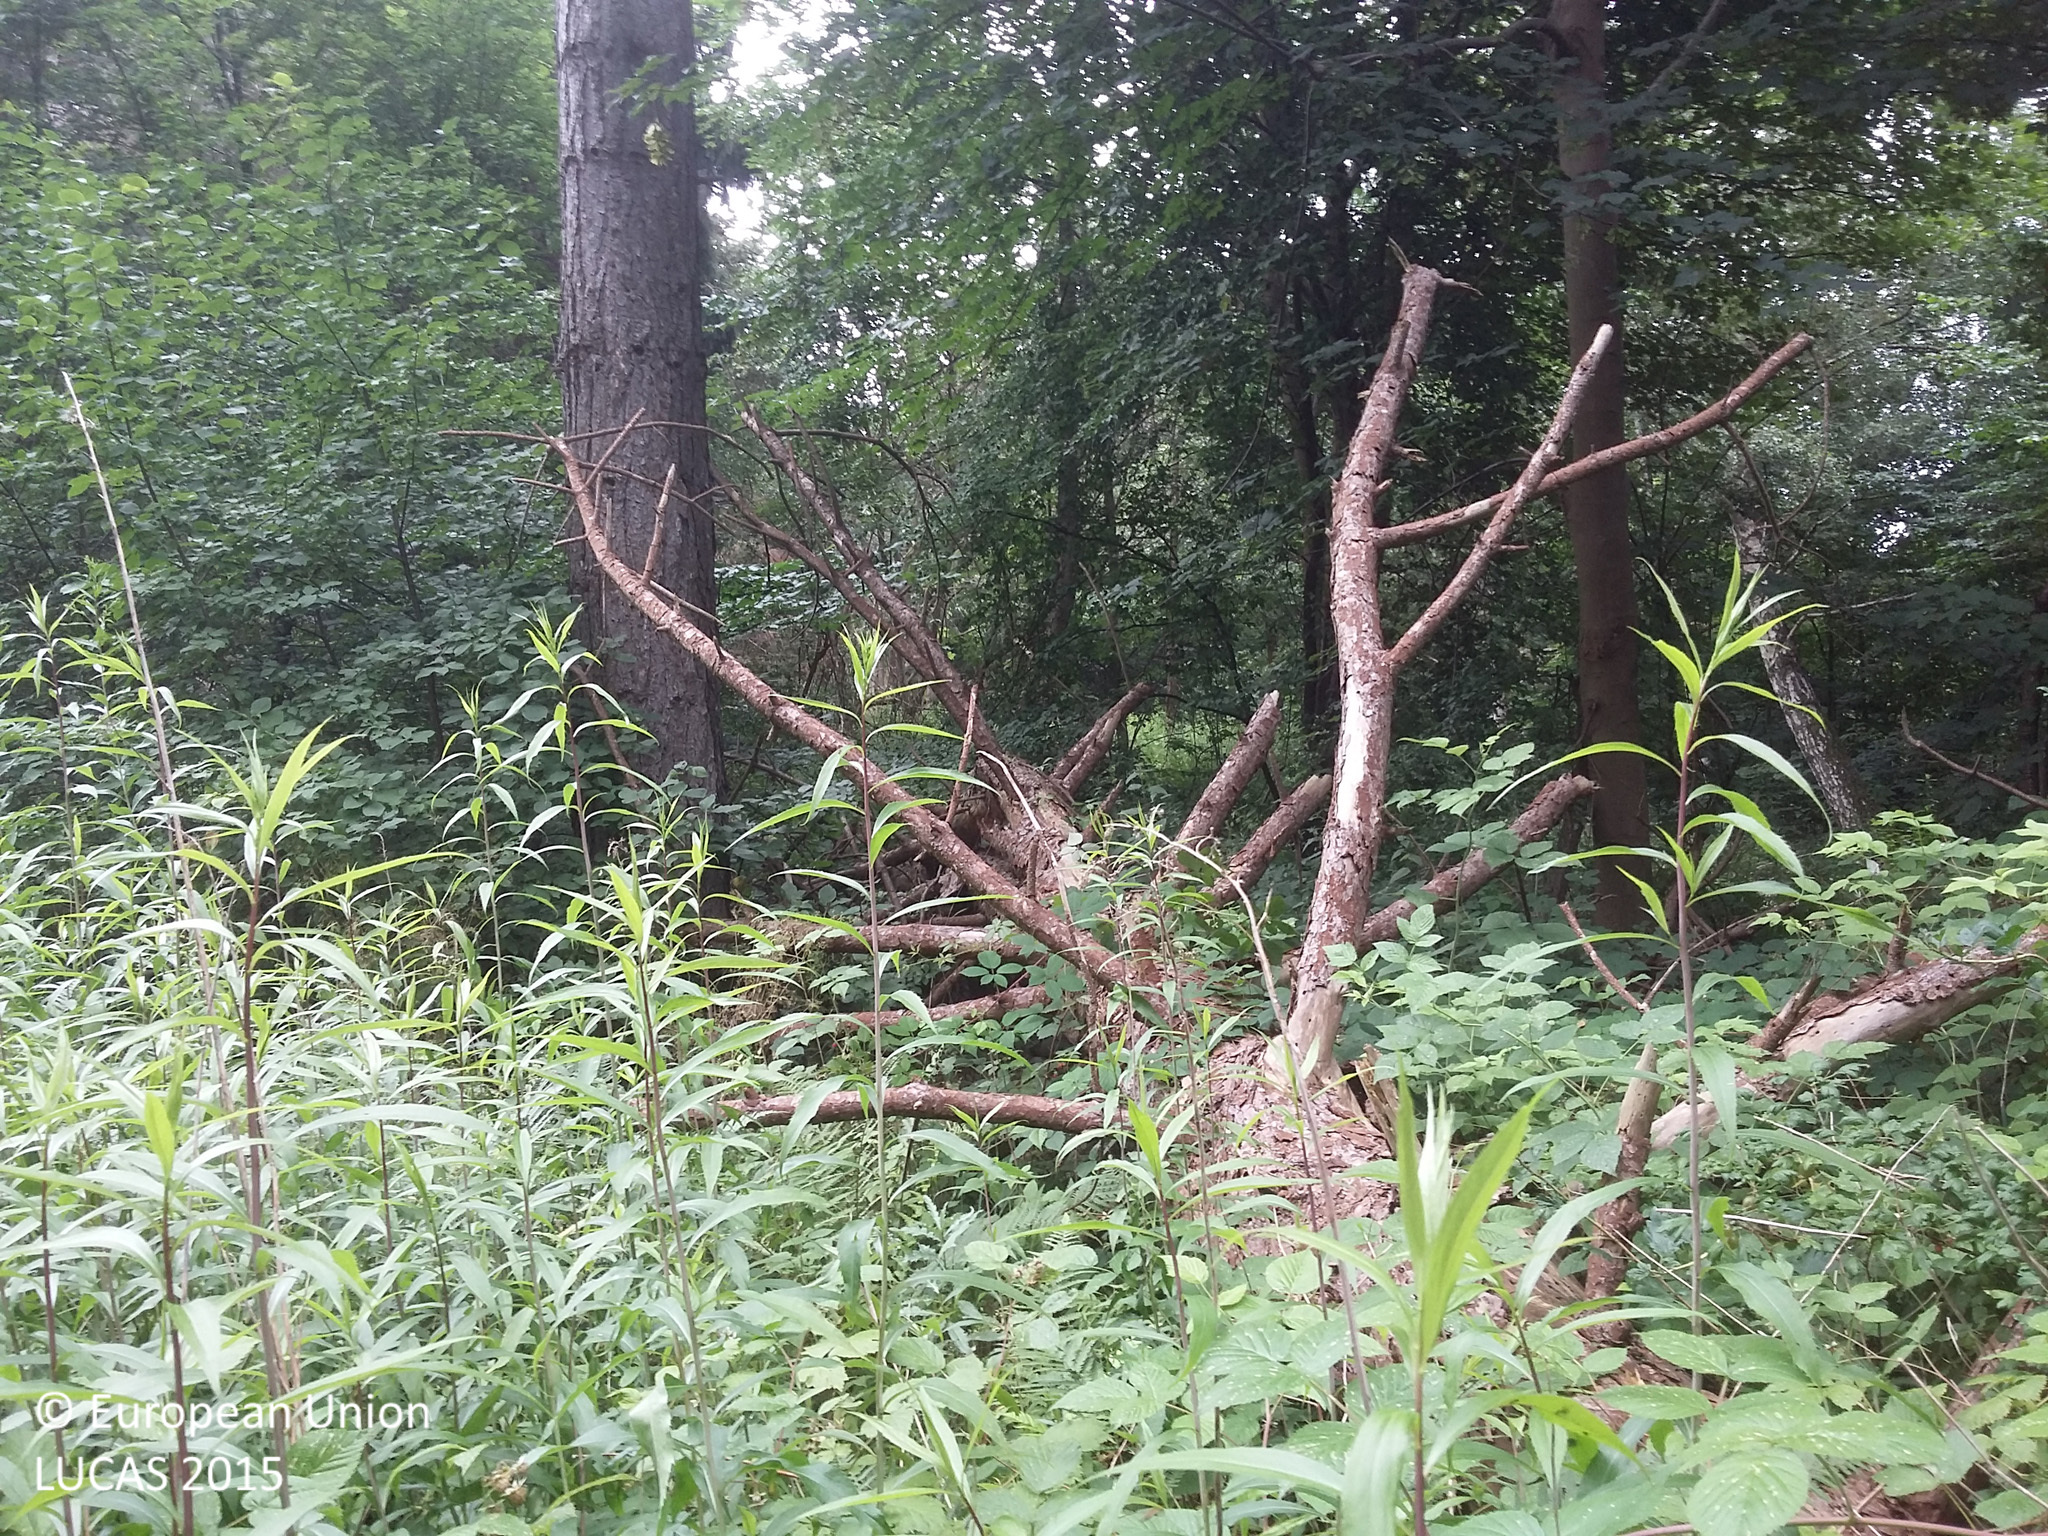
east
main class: Woodland
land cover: Broadleaved woodland
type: thermophilous deciduous forest
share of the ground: 50 - 75 %
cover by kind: herbaceous plants 50 %, broadleaved forest trees 45 %, coniferous forest trees 5 %
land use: Semi-natural and natural areas not in use
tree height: > 5 m
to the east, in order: Broadleaved woodland; Tracks; Broadleaved woodland; Tracks; Broadleaved woodland; Inland marshes; Ditches and canals; Inland marshes
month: July
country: DK
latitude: 55.8031
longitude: 12.5345
